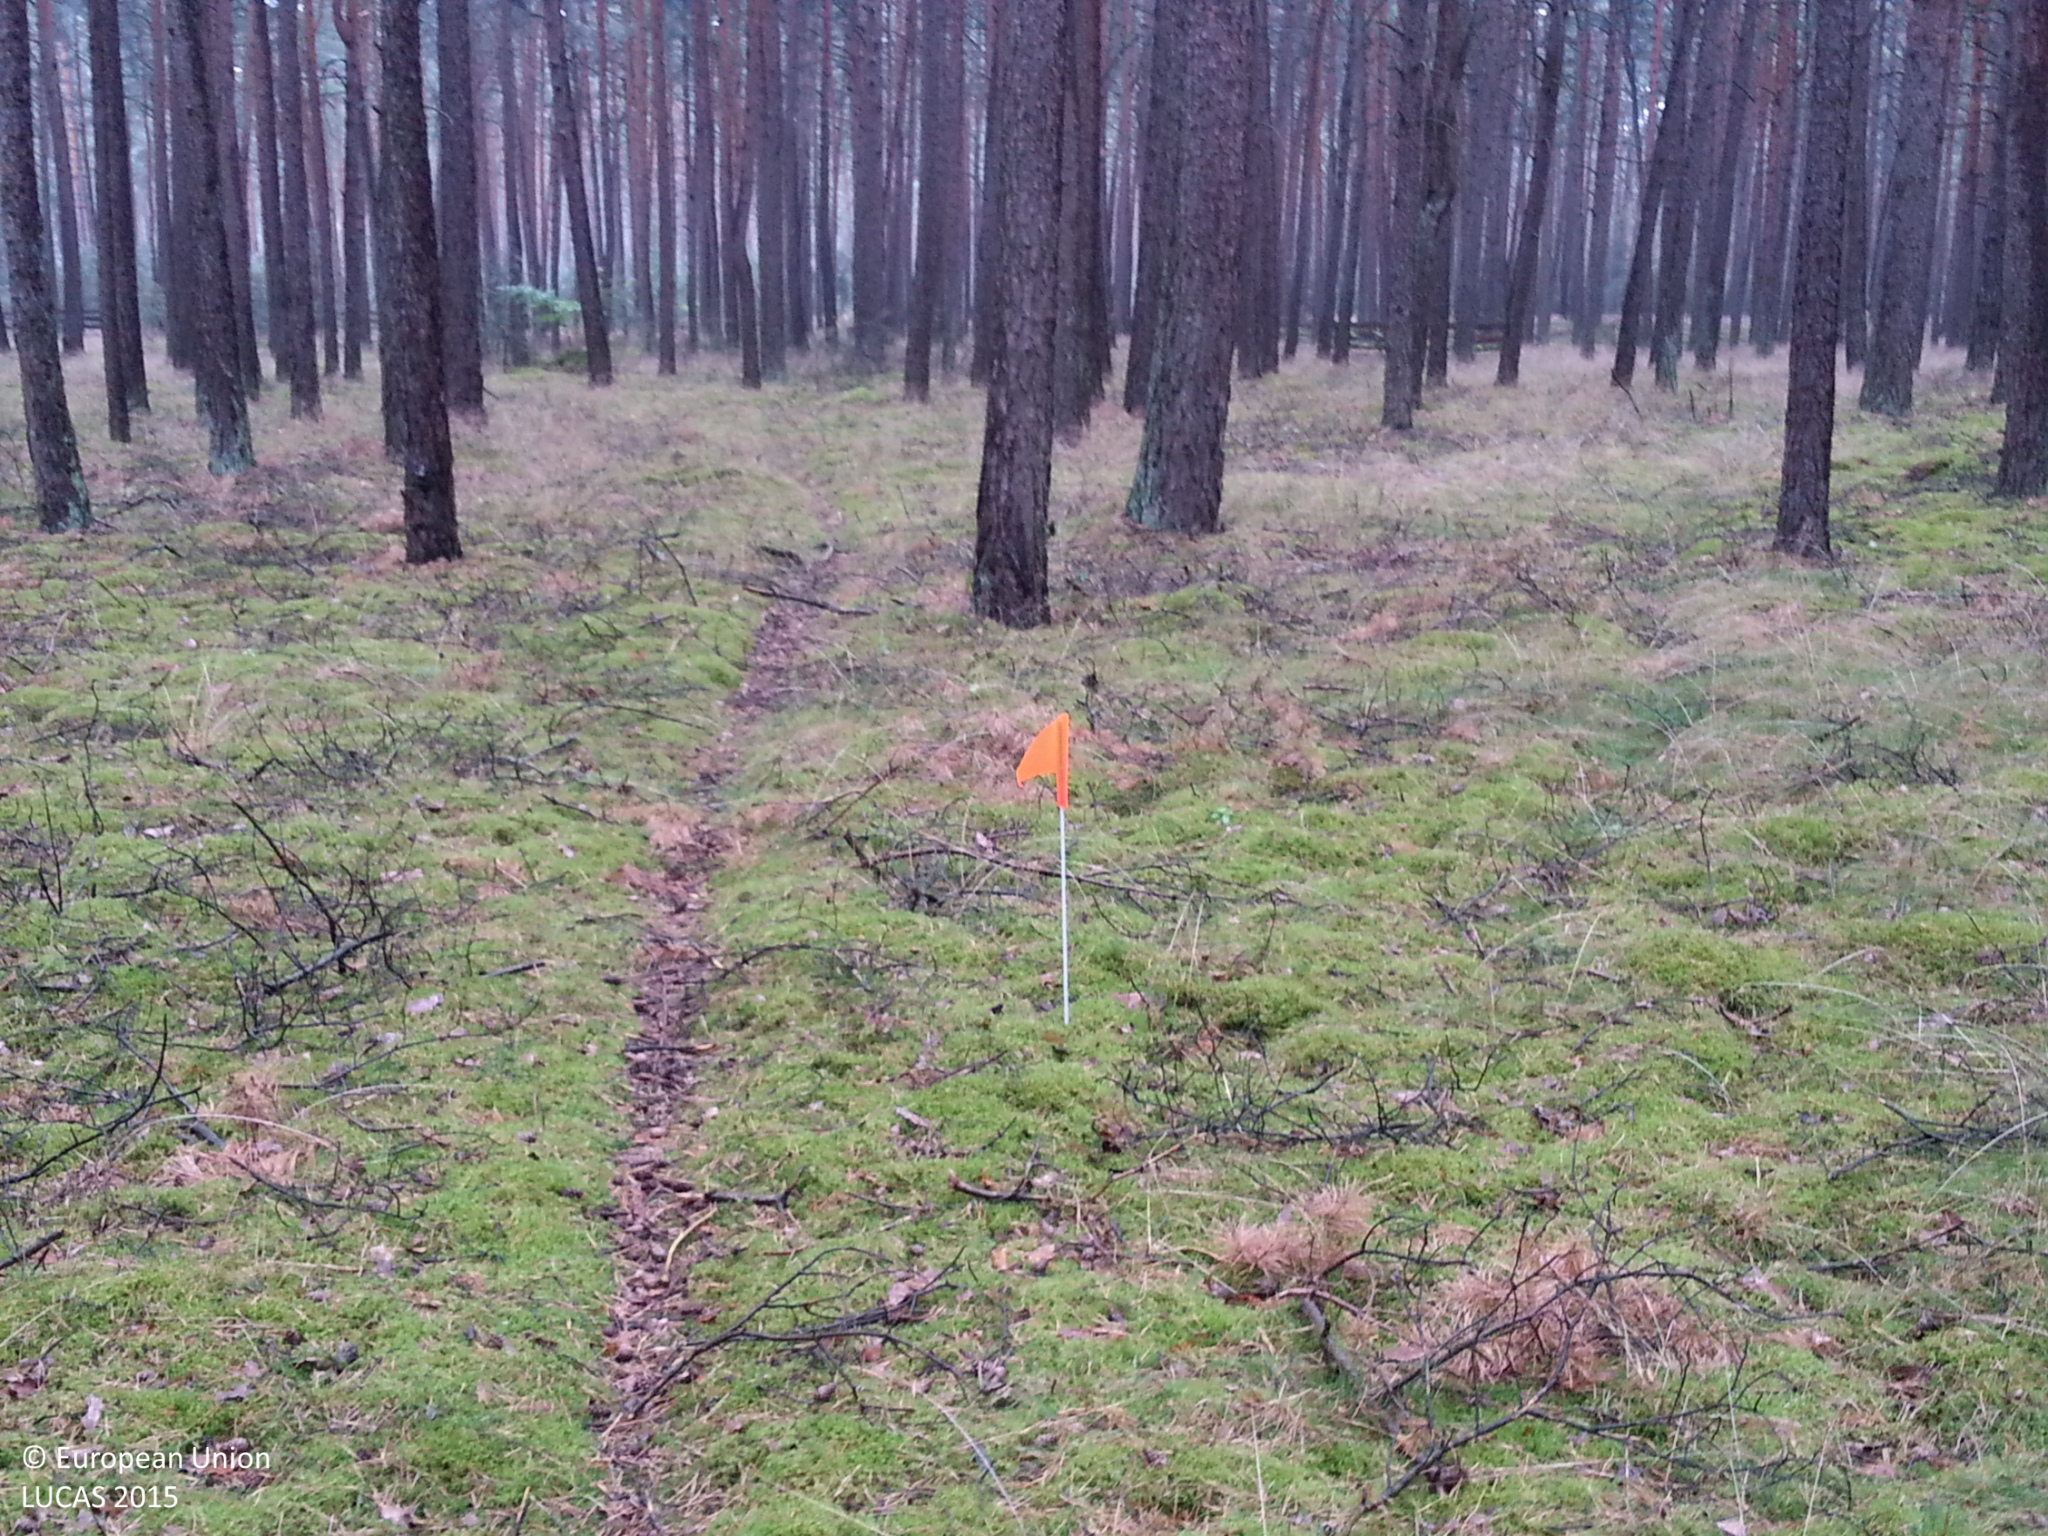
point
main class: Woodland
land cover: Pine dominated coniferous woodland
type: hemiboreal forest and nemoral coniferous forest and mixed broadleaved-coniferous forest
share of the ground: > 75 %
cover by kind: coniferous forest trees 75 %, herbaceous plants 25 %
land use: Forestry
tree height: > 5 m
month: July
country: DE
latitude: 52.9842
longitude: 11.0274
